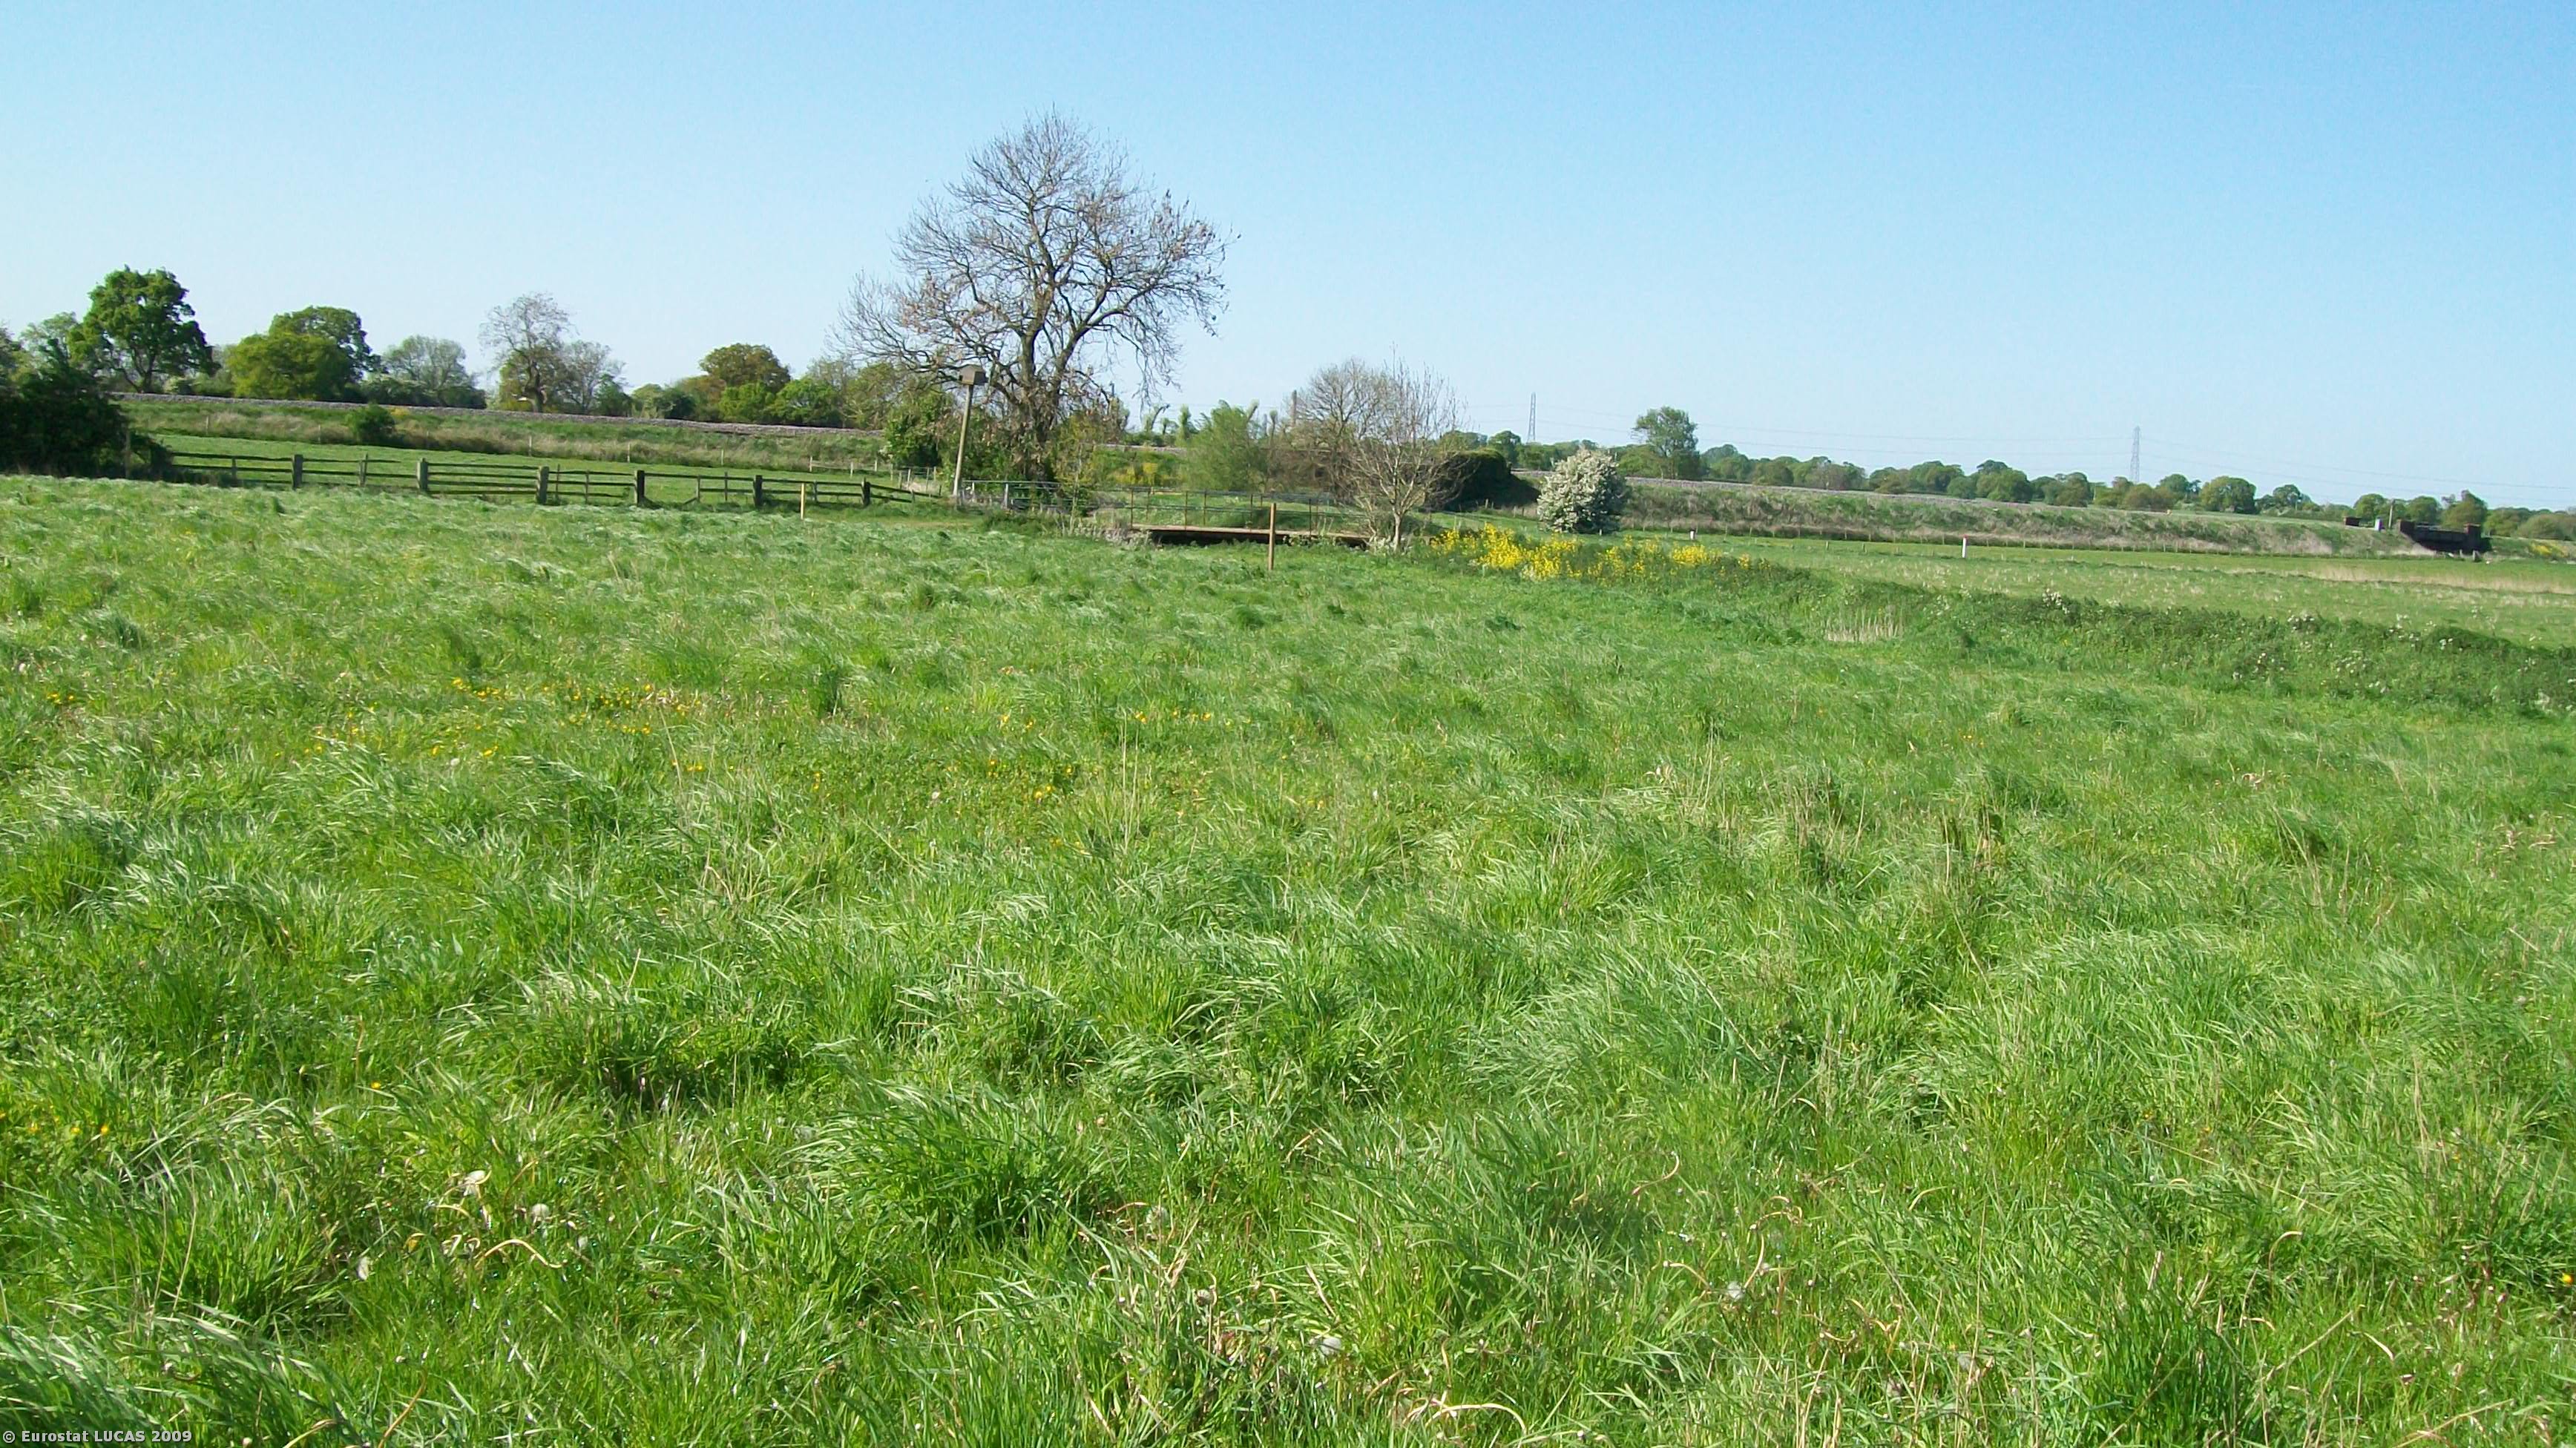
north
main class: Grassland
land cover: Grassland without tree/shrub cover
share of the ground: > 75 %
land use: Agriculture (excluding fallow land and kitchen gardens)
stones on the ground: < 10 %
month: May
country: GB
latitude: 53.2271
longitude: -2.8187
